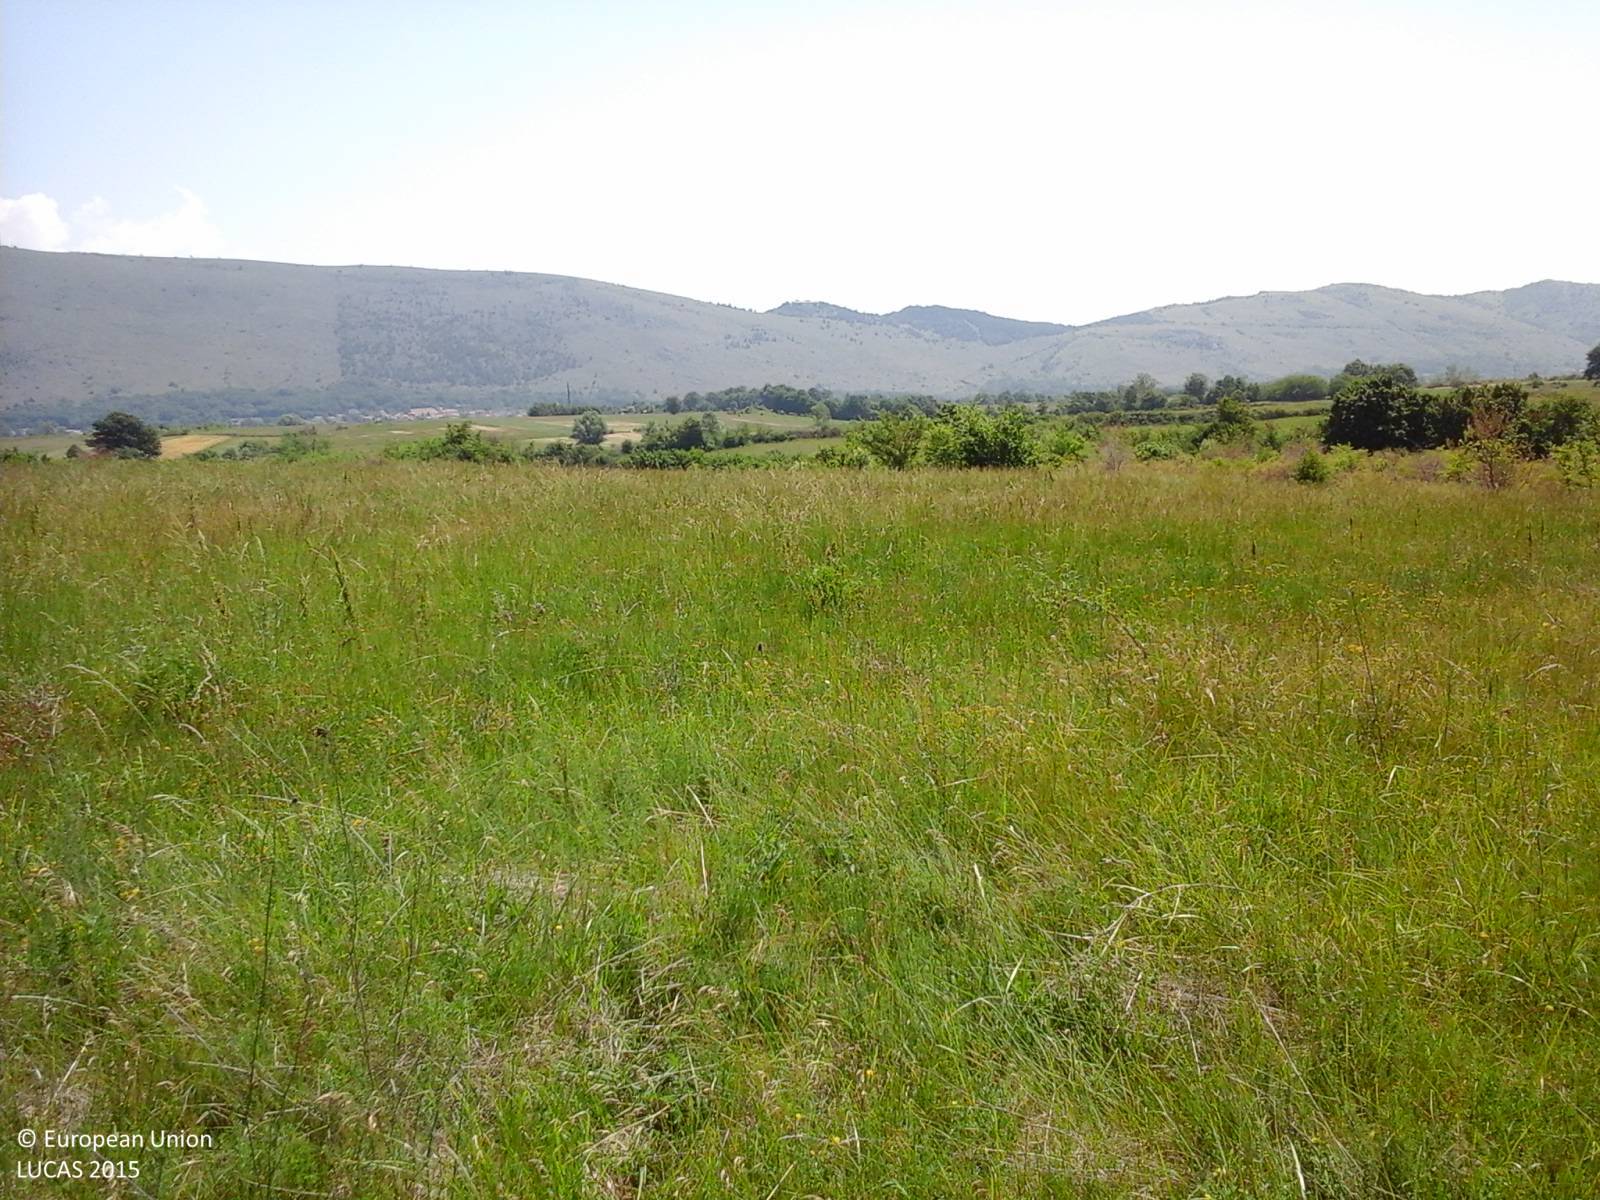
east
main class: Grassland
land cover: Grassland without tree/shrub cover
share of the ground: > 75 %
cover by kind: herbaceous plants 100 %
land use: Agriculture (excluding fallow land and kitchen gardens)
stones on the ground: < 10 %
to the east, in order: Grassland without tree/shrub cover; Mixed cereals for fodder; Grassland without tree/shrub cover; Shrubland without tree cover; Grassland without tree/shrub cover; Shrubland with sparse tree cover; Grassland without tree/shrub cover; Abandoned hedges; Grassland without tree/shrub cover
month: June
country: IT
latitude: 42.0198
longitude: 13.3577
